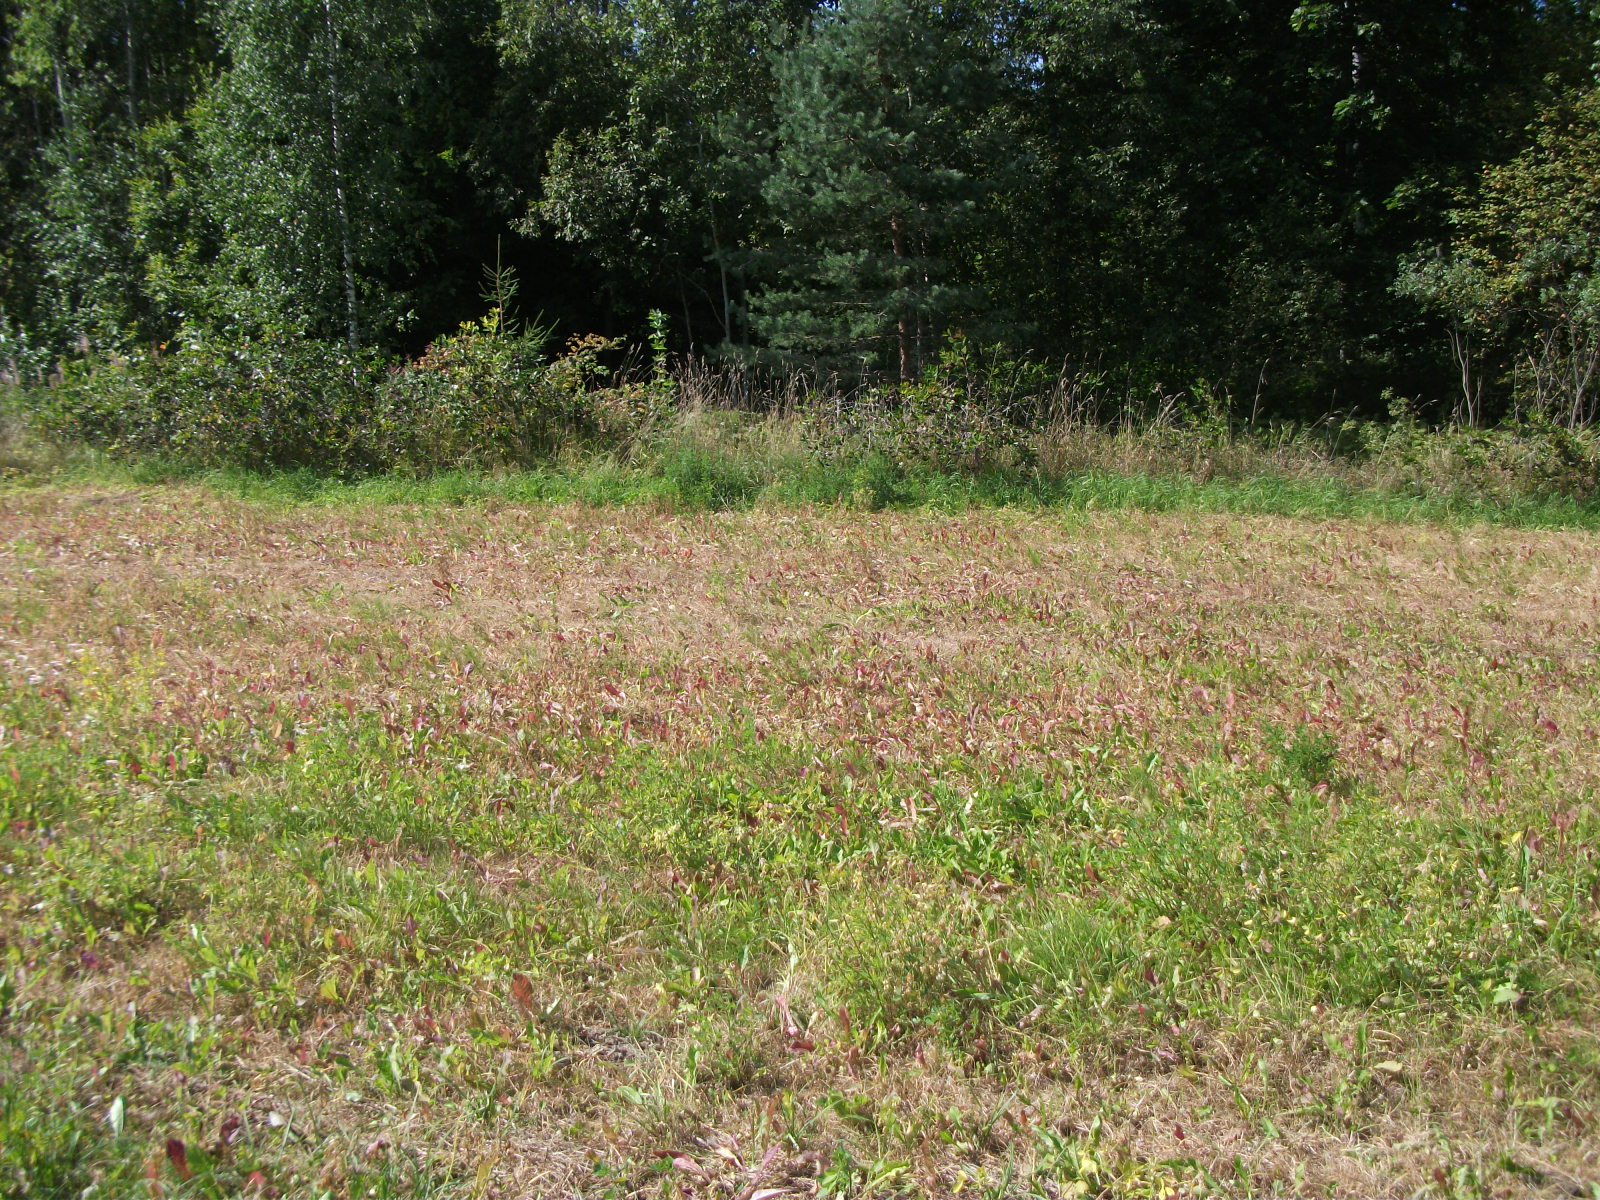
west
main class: Grassland
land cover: Grassland without tree/shrub cover
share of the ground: > 75 %
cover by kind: herbaceous plants 100 %
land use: Agriculture (excluding fallow land and kitchen gardens)
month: August
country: LV
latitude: 56.1828
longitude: 26.3029
